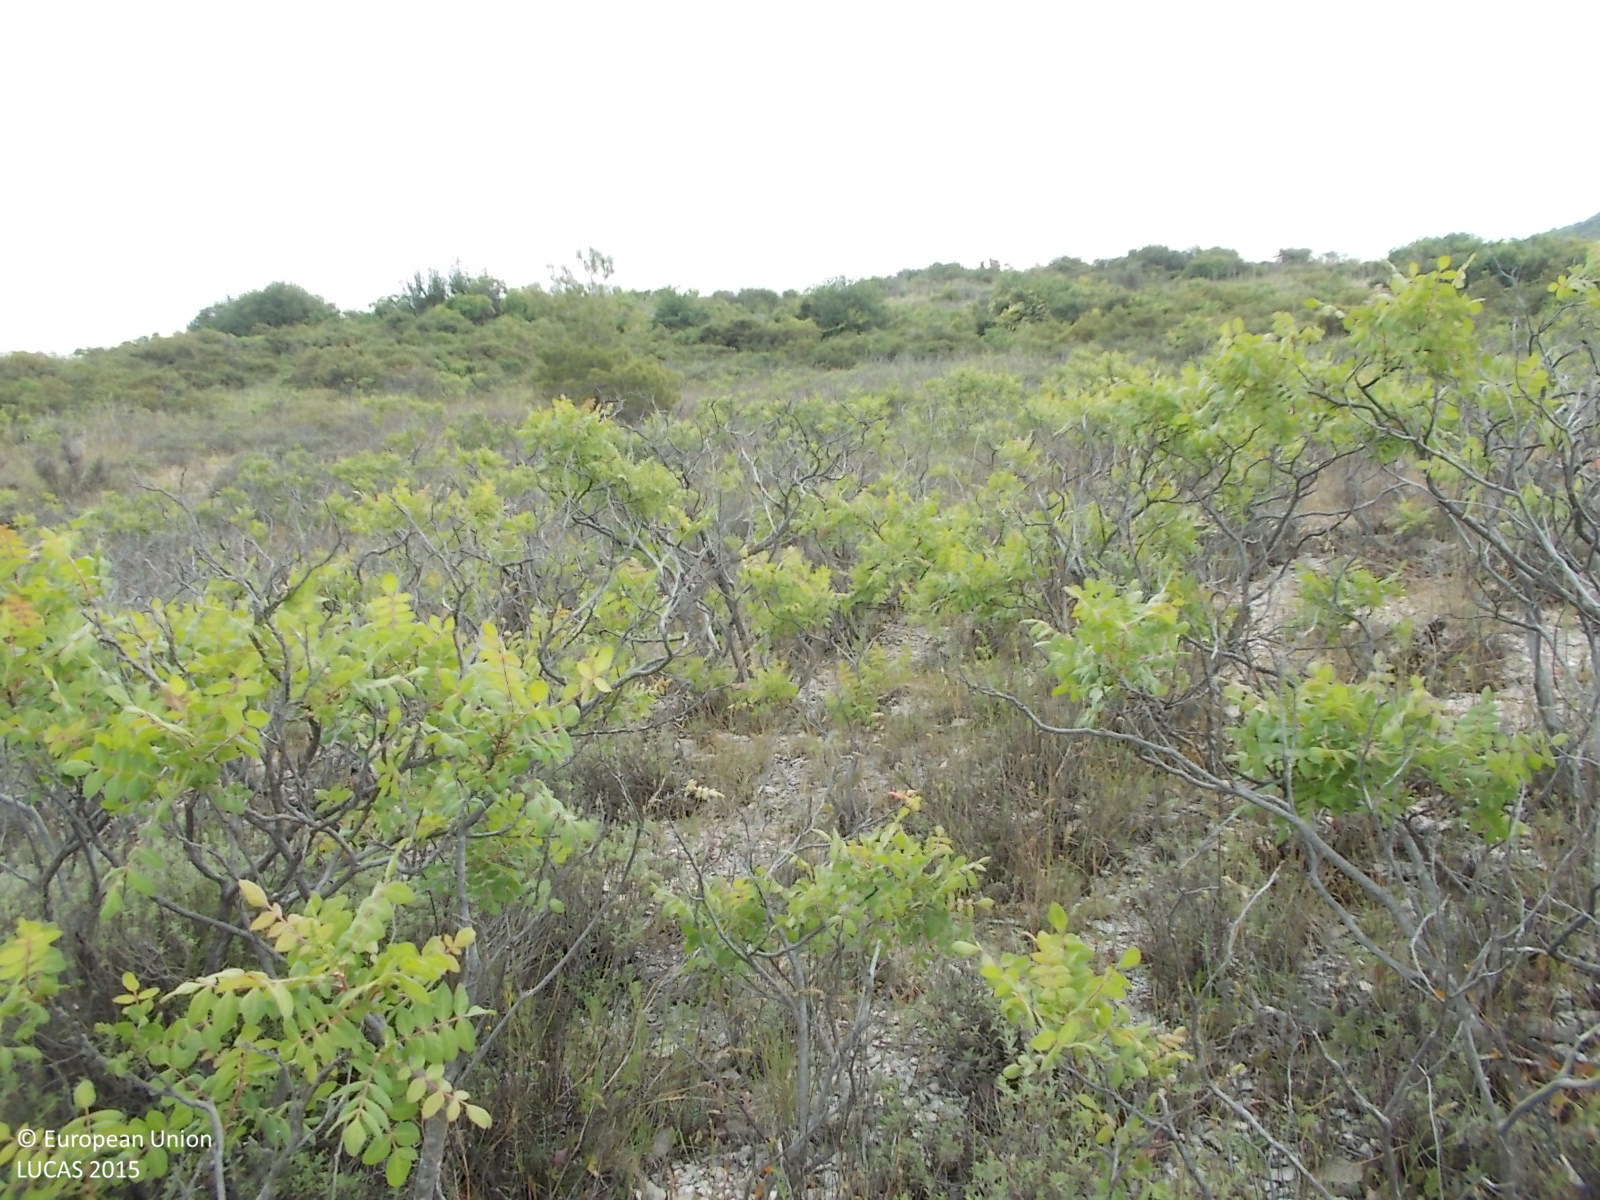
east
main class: Cropland
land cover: Cherry fruit
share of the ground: 50 - 75 %
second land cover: Shrubland without tree cover
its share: 25 - 50 %
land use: Abandoned areas
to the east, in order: Cherry fruit; Shrubland without tree cover; Vineyards; Shrubland with sparse tree cover; Tracks; Shrubland with sparse tree cover; Vineyards; Shrubland with sparse tree cover; Artificial constructions in urban areas; Shrubland with sparse tree cover; Tracks
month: June
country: CY
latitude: 34.8545
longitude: 32.8360
